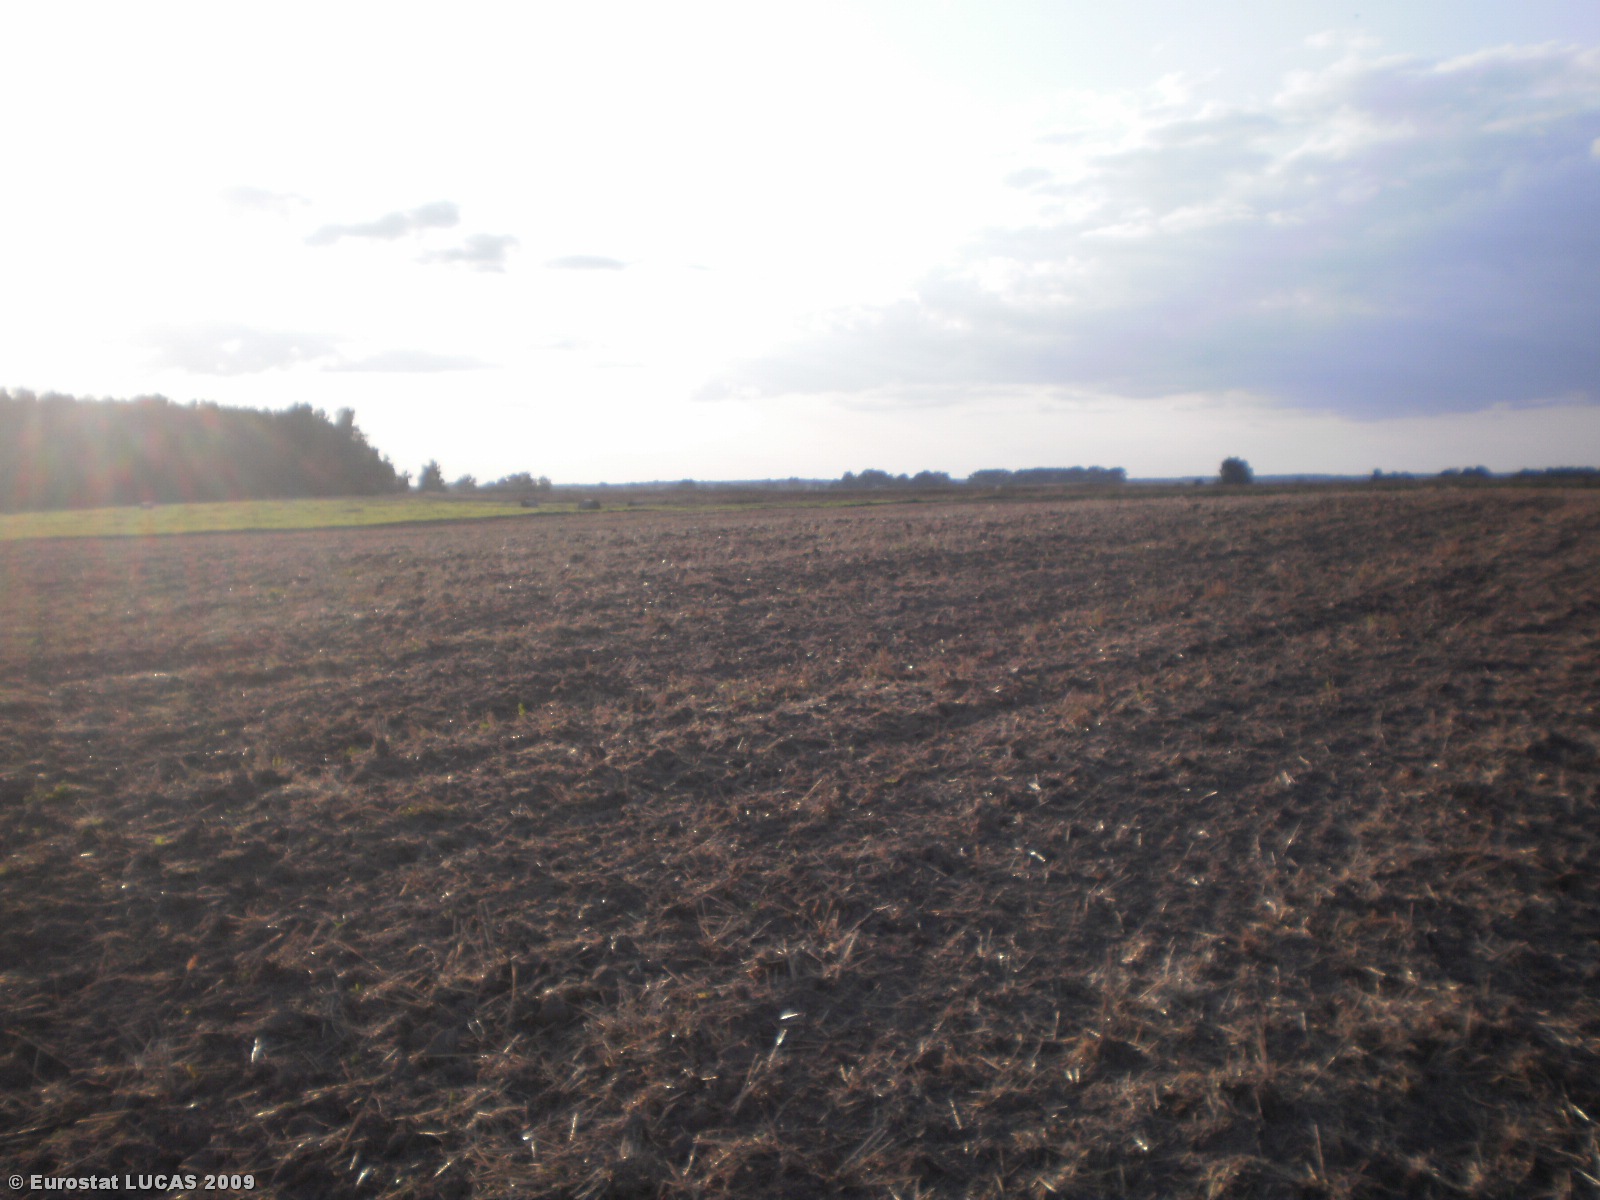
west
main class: Cropland
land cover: Common wheat
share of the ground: < 10 %
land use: Agriculture (excluding fallow land and kitchen gardens)
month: August
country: LT
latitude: 55.4680
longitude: 24.9640
